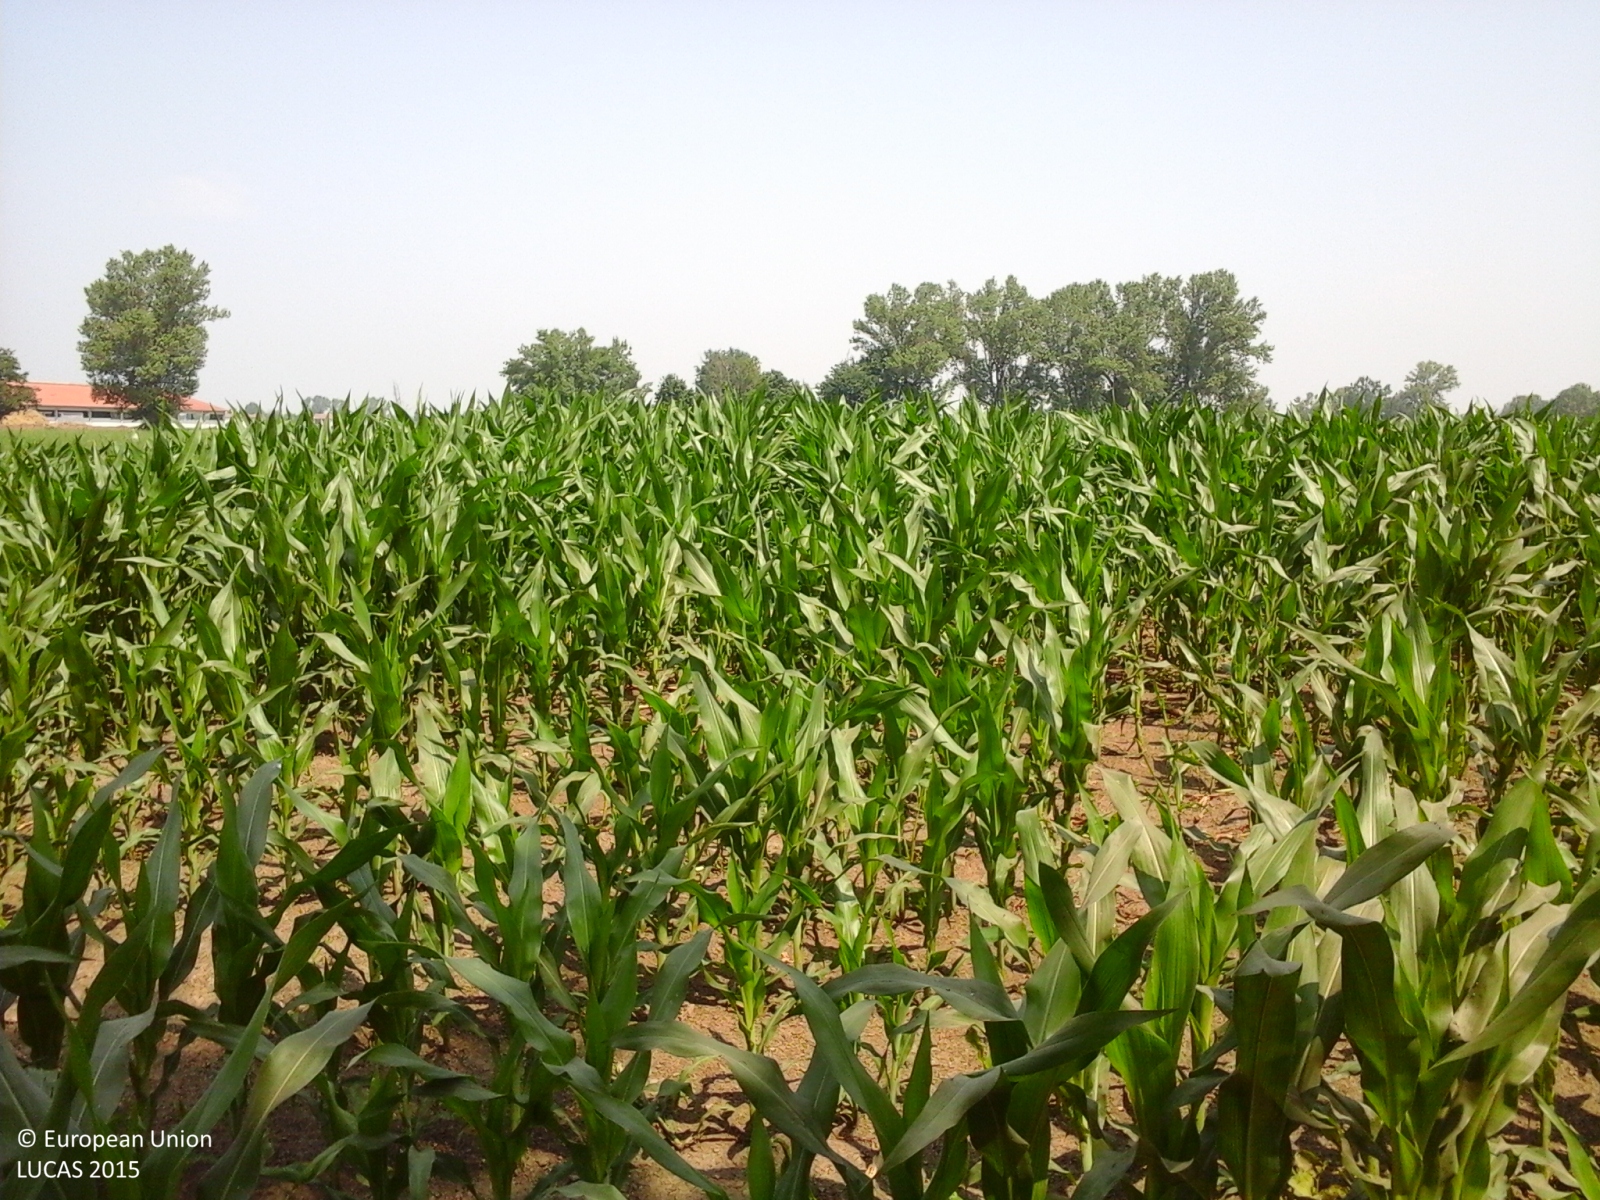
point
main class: Cropland
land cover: Maize
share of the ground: > 75 %
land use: Agriculture (excluding fallow land and kitchen gardens)
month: June
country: IT
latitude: 44.9996
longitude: 10.1646
